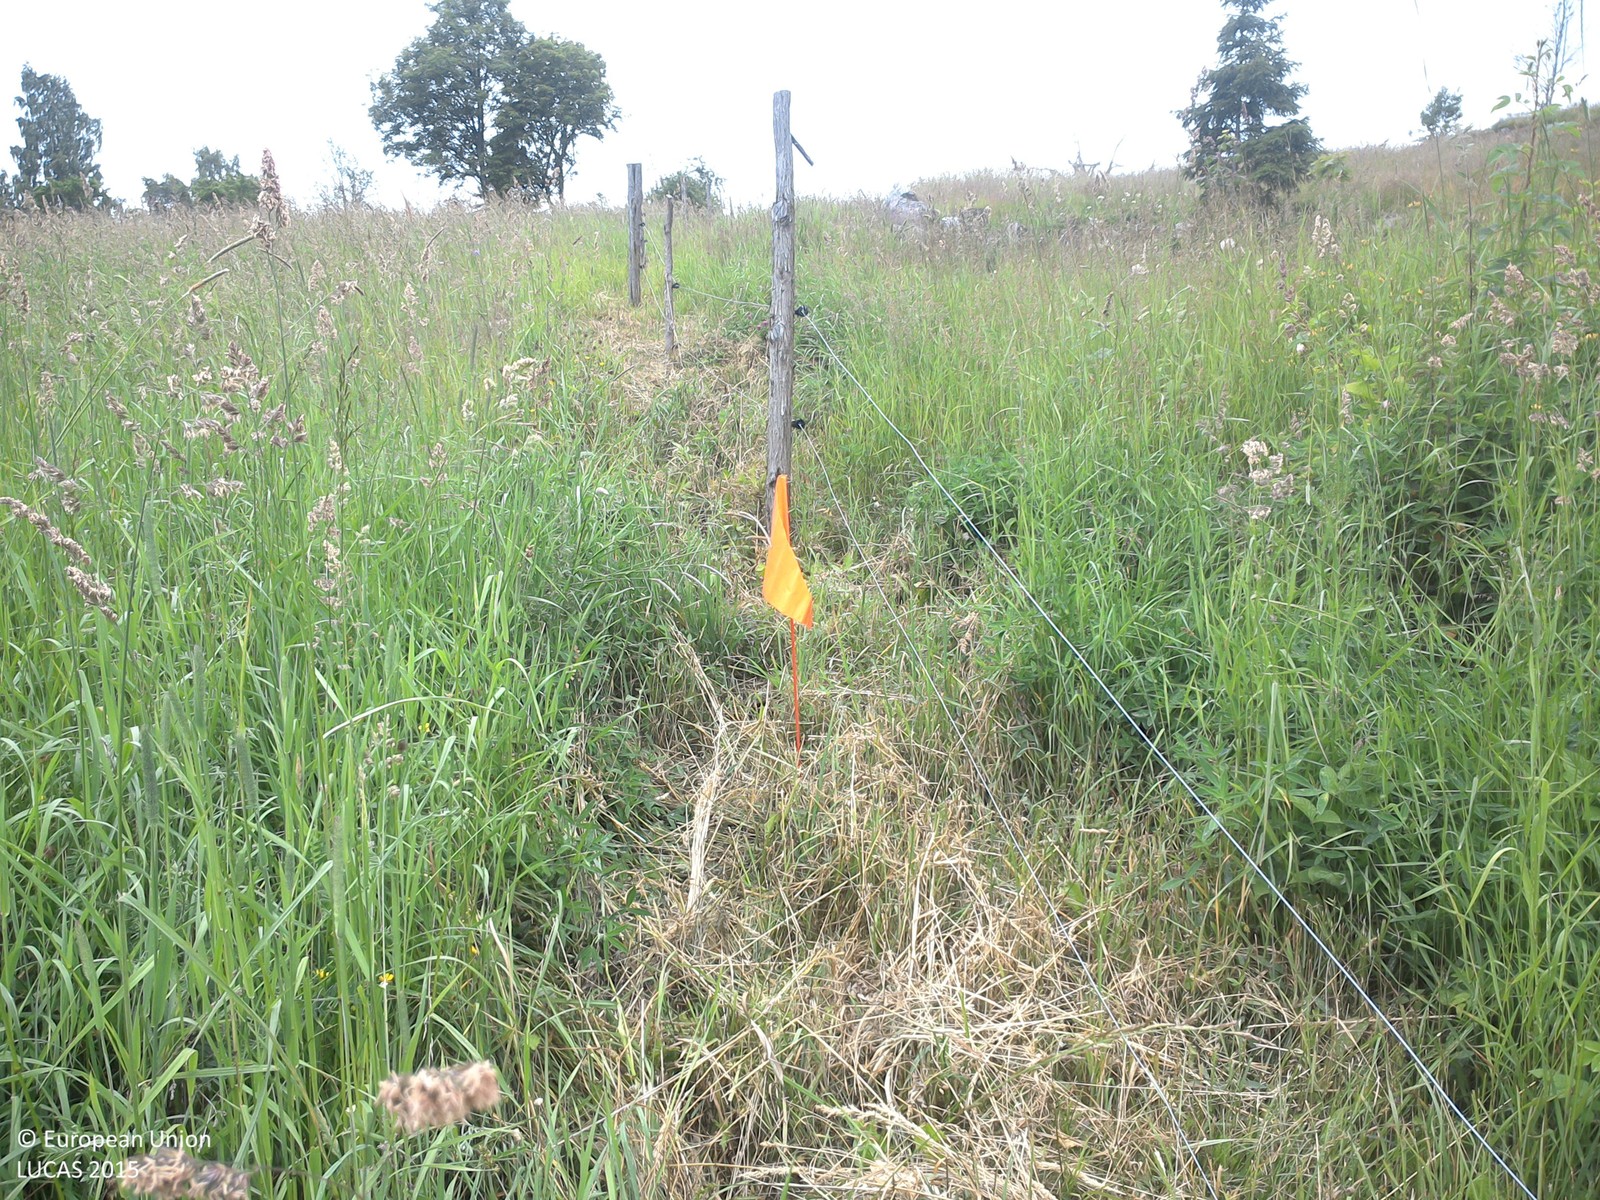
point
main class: Grassland
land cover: Grassland without tree/shrub cover
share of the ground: > 75 %
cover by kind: herbaceous plants 100 %
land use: Agriculture (excluding fallow land and kitchen gardens)
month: June
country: SE
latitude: 58.2899
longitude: 15.4360
